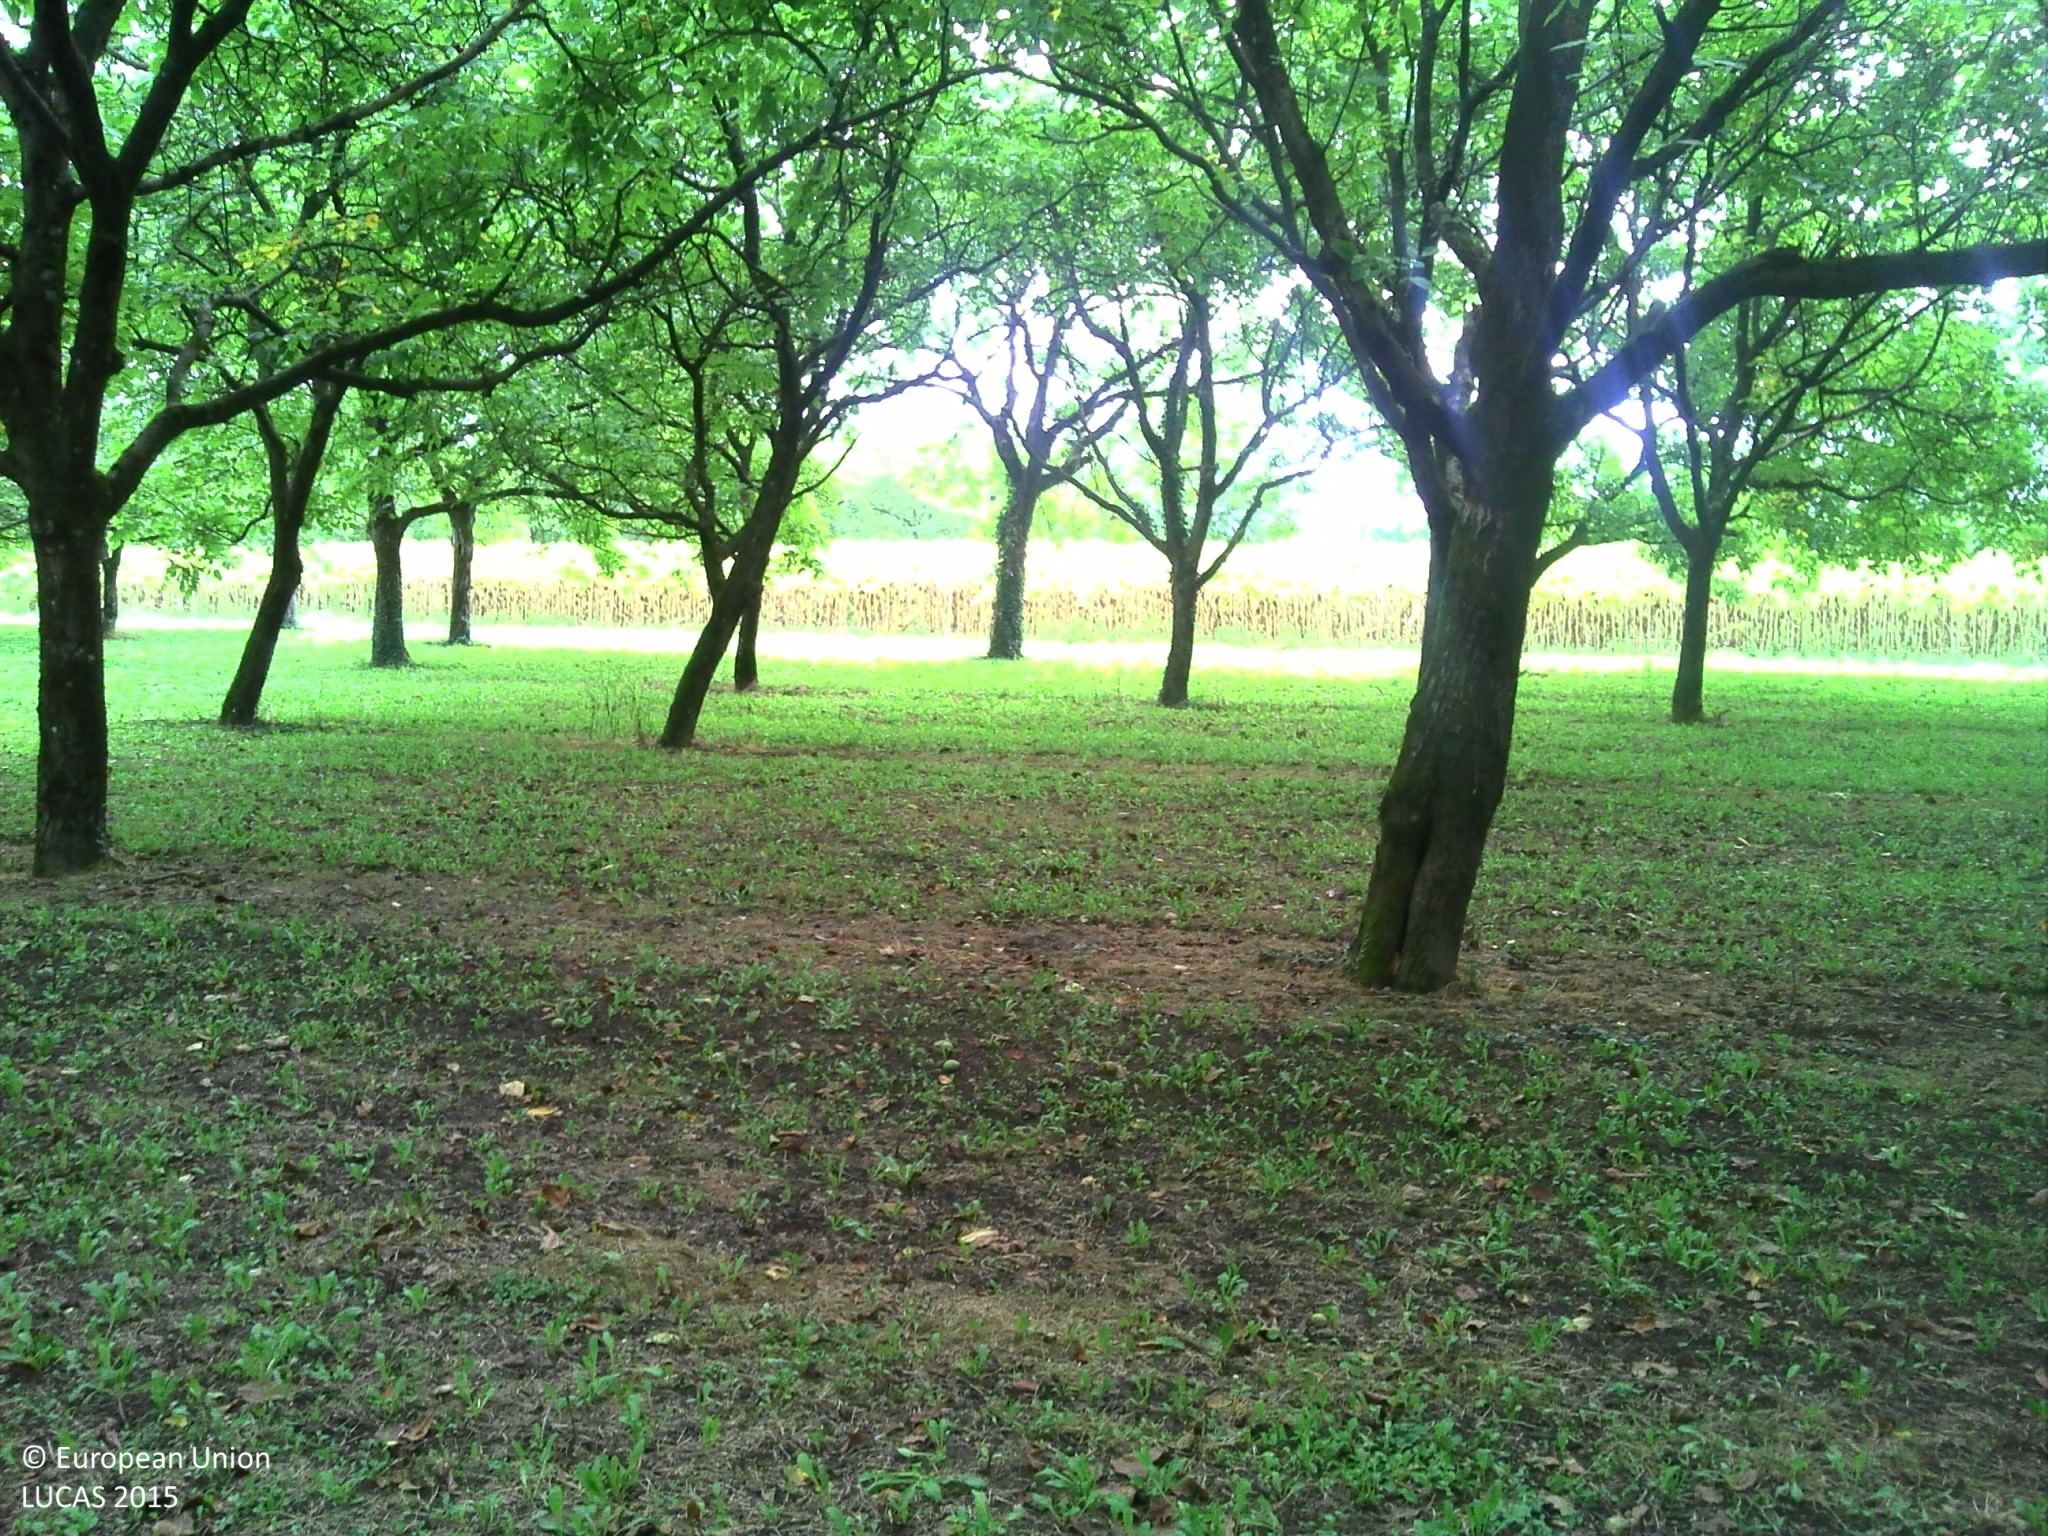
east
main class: Cropland
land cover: Nuts trees
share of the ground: 50 - 75 %
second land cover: Spontaneously vegetated surfaces
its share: > 75 %
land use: Agriculture (excluding fallow land and kitchen gardens)
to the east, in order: Nuts trees; Spontaneously vegetated surfaces; Sunflower; Tracks; Nuts trees; Tracks; Spontaneously vegetated surfaces; Fences; Grassland without tree/shrub cover; Fences; Single bushes/trees; Grass margins
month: August
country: FR
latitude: 45.3374
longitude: 5.5259
